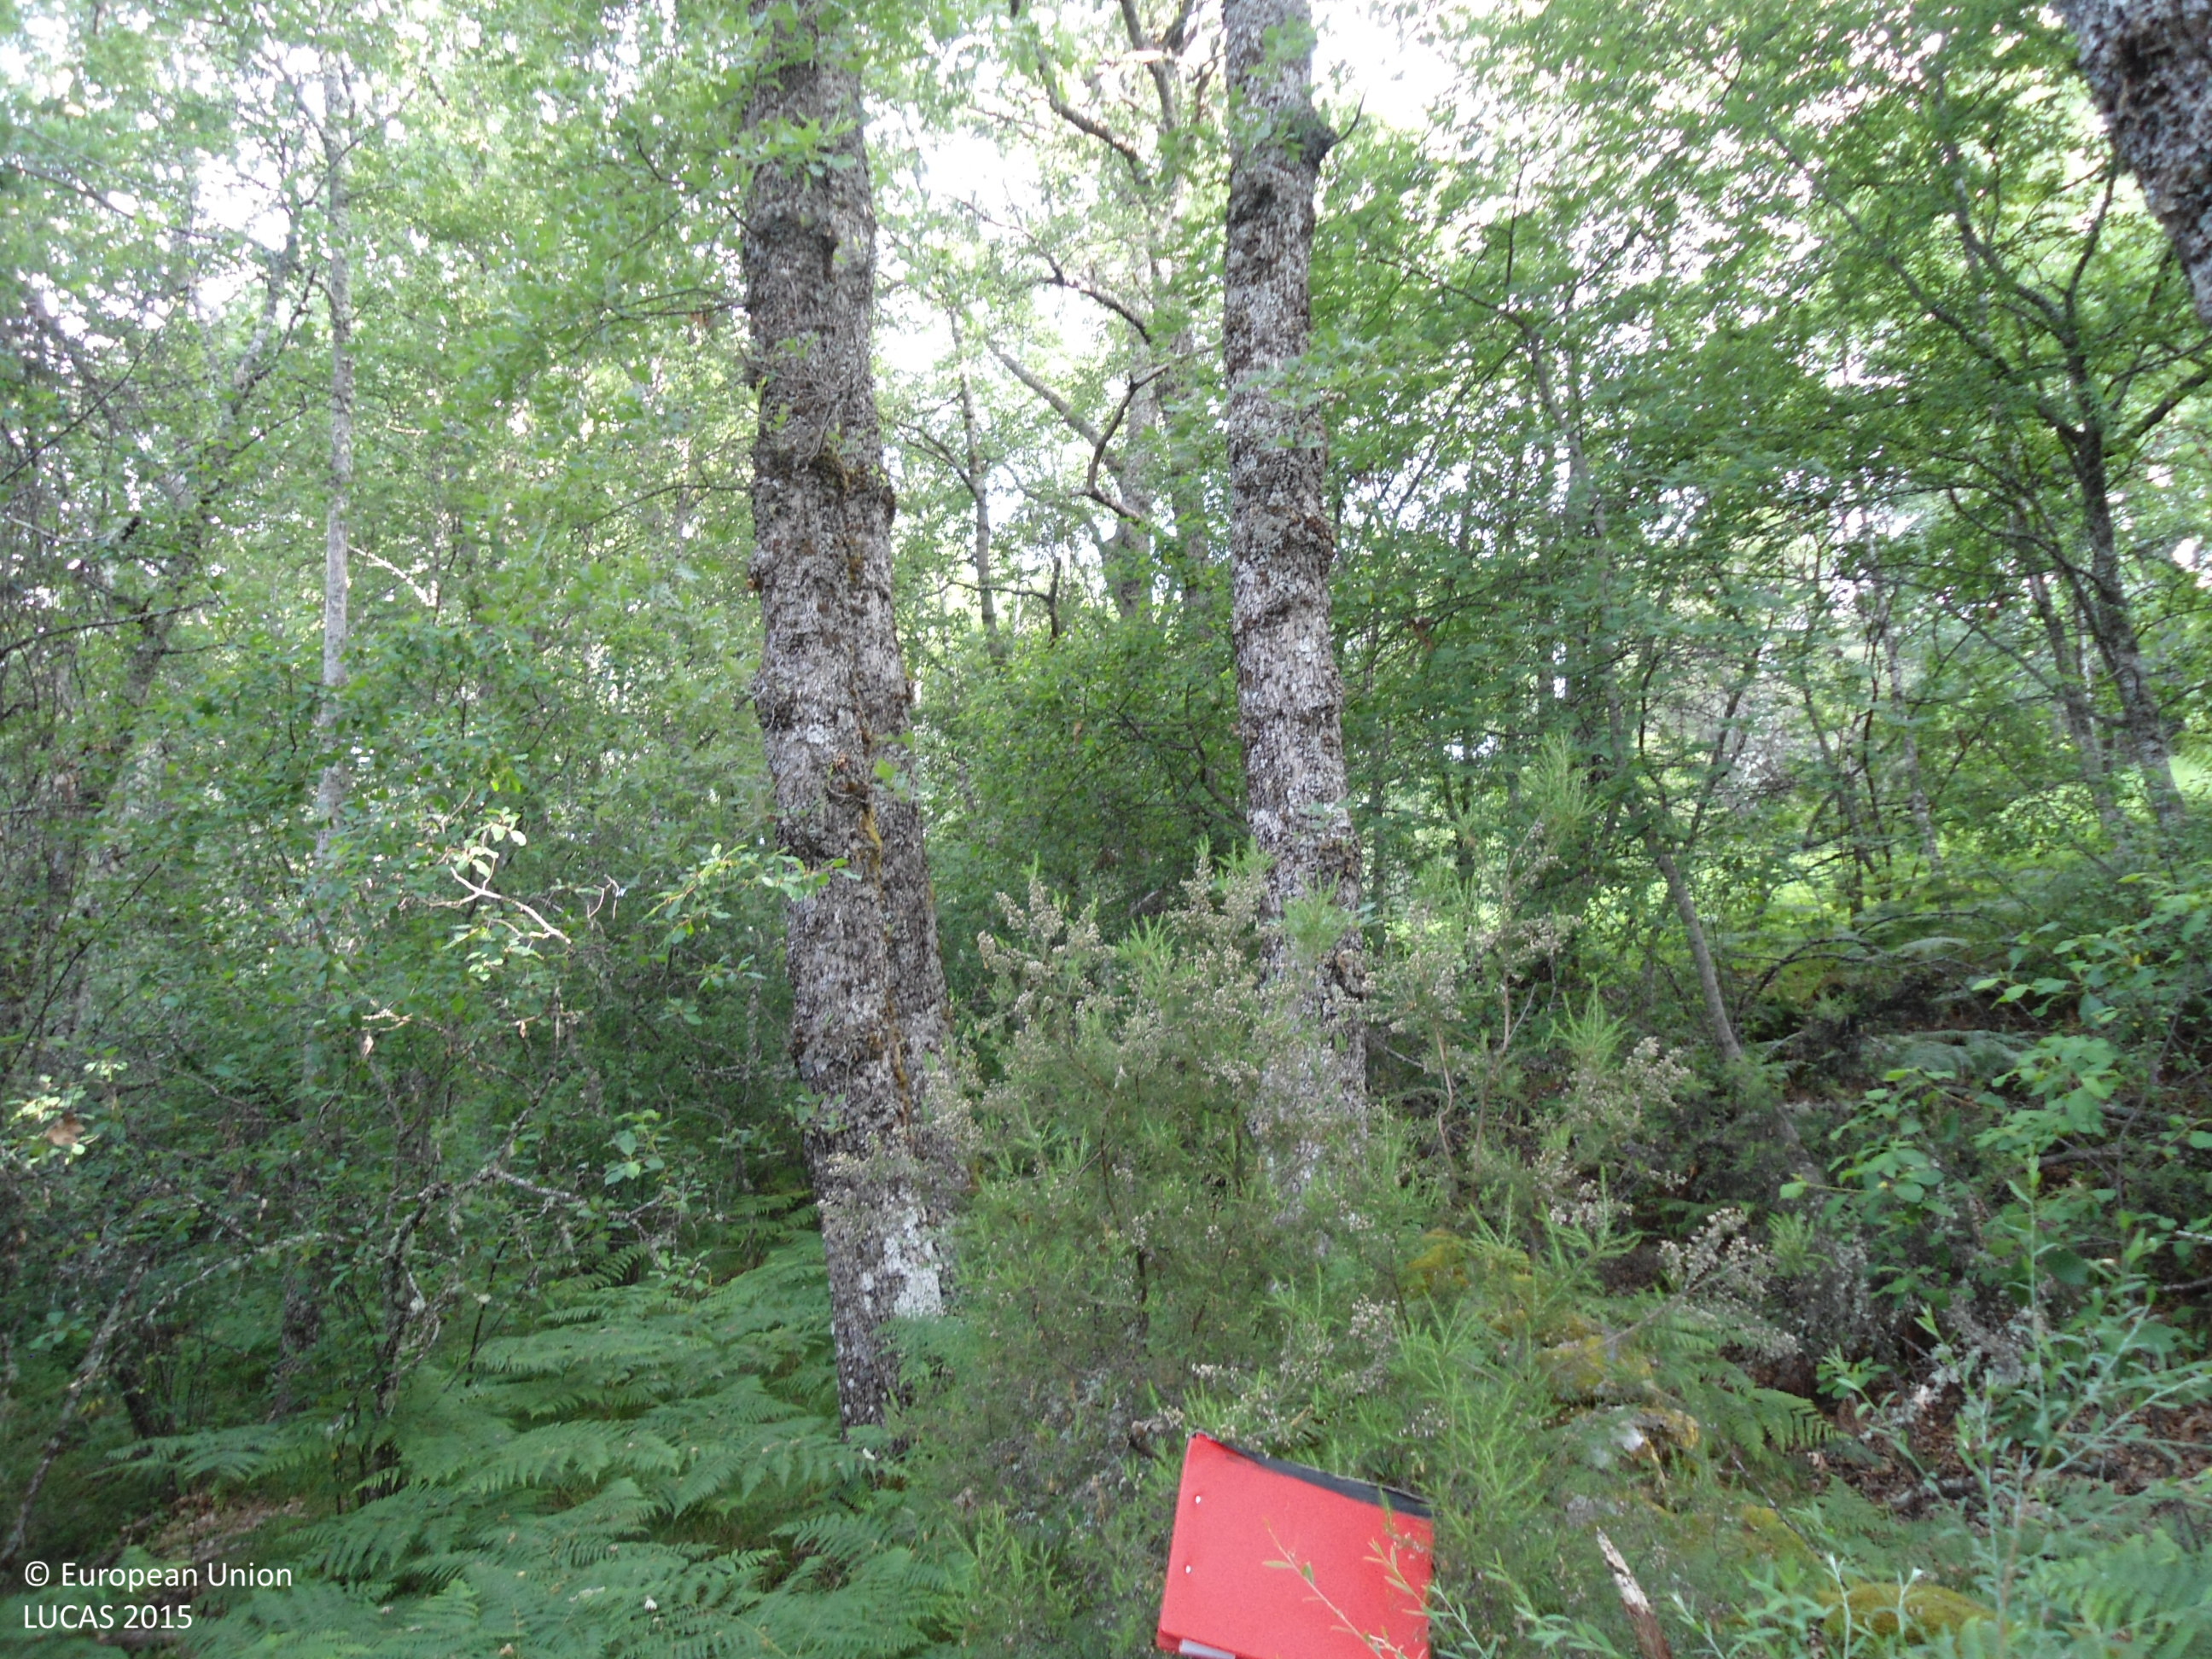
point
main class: Woodland
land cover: Broadleaved woodland
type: thermophilous deciduous forest
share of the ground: > 75 %
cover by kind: broadleaved forest trees 100 %
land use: Forestry
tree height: > 5 m
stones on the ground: < 10 %
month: June
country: ES
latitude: 42.0348
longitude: -6.7743
